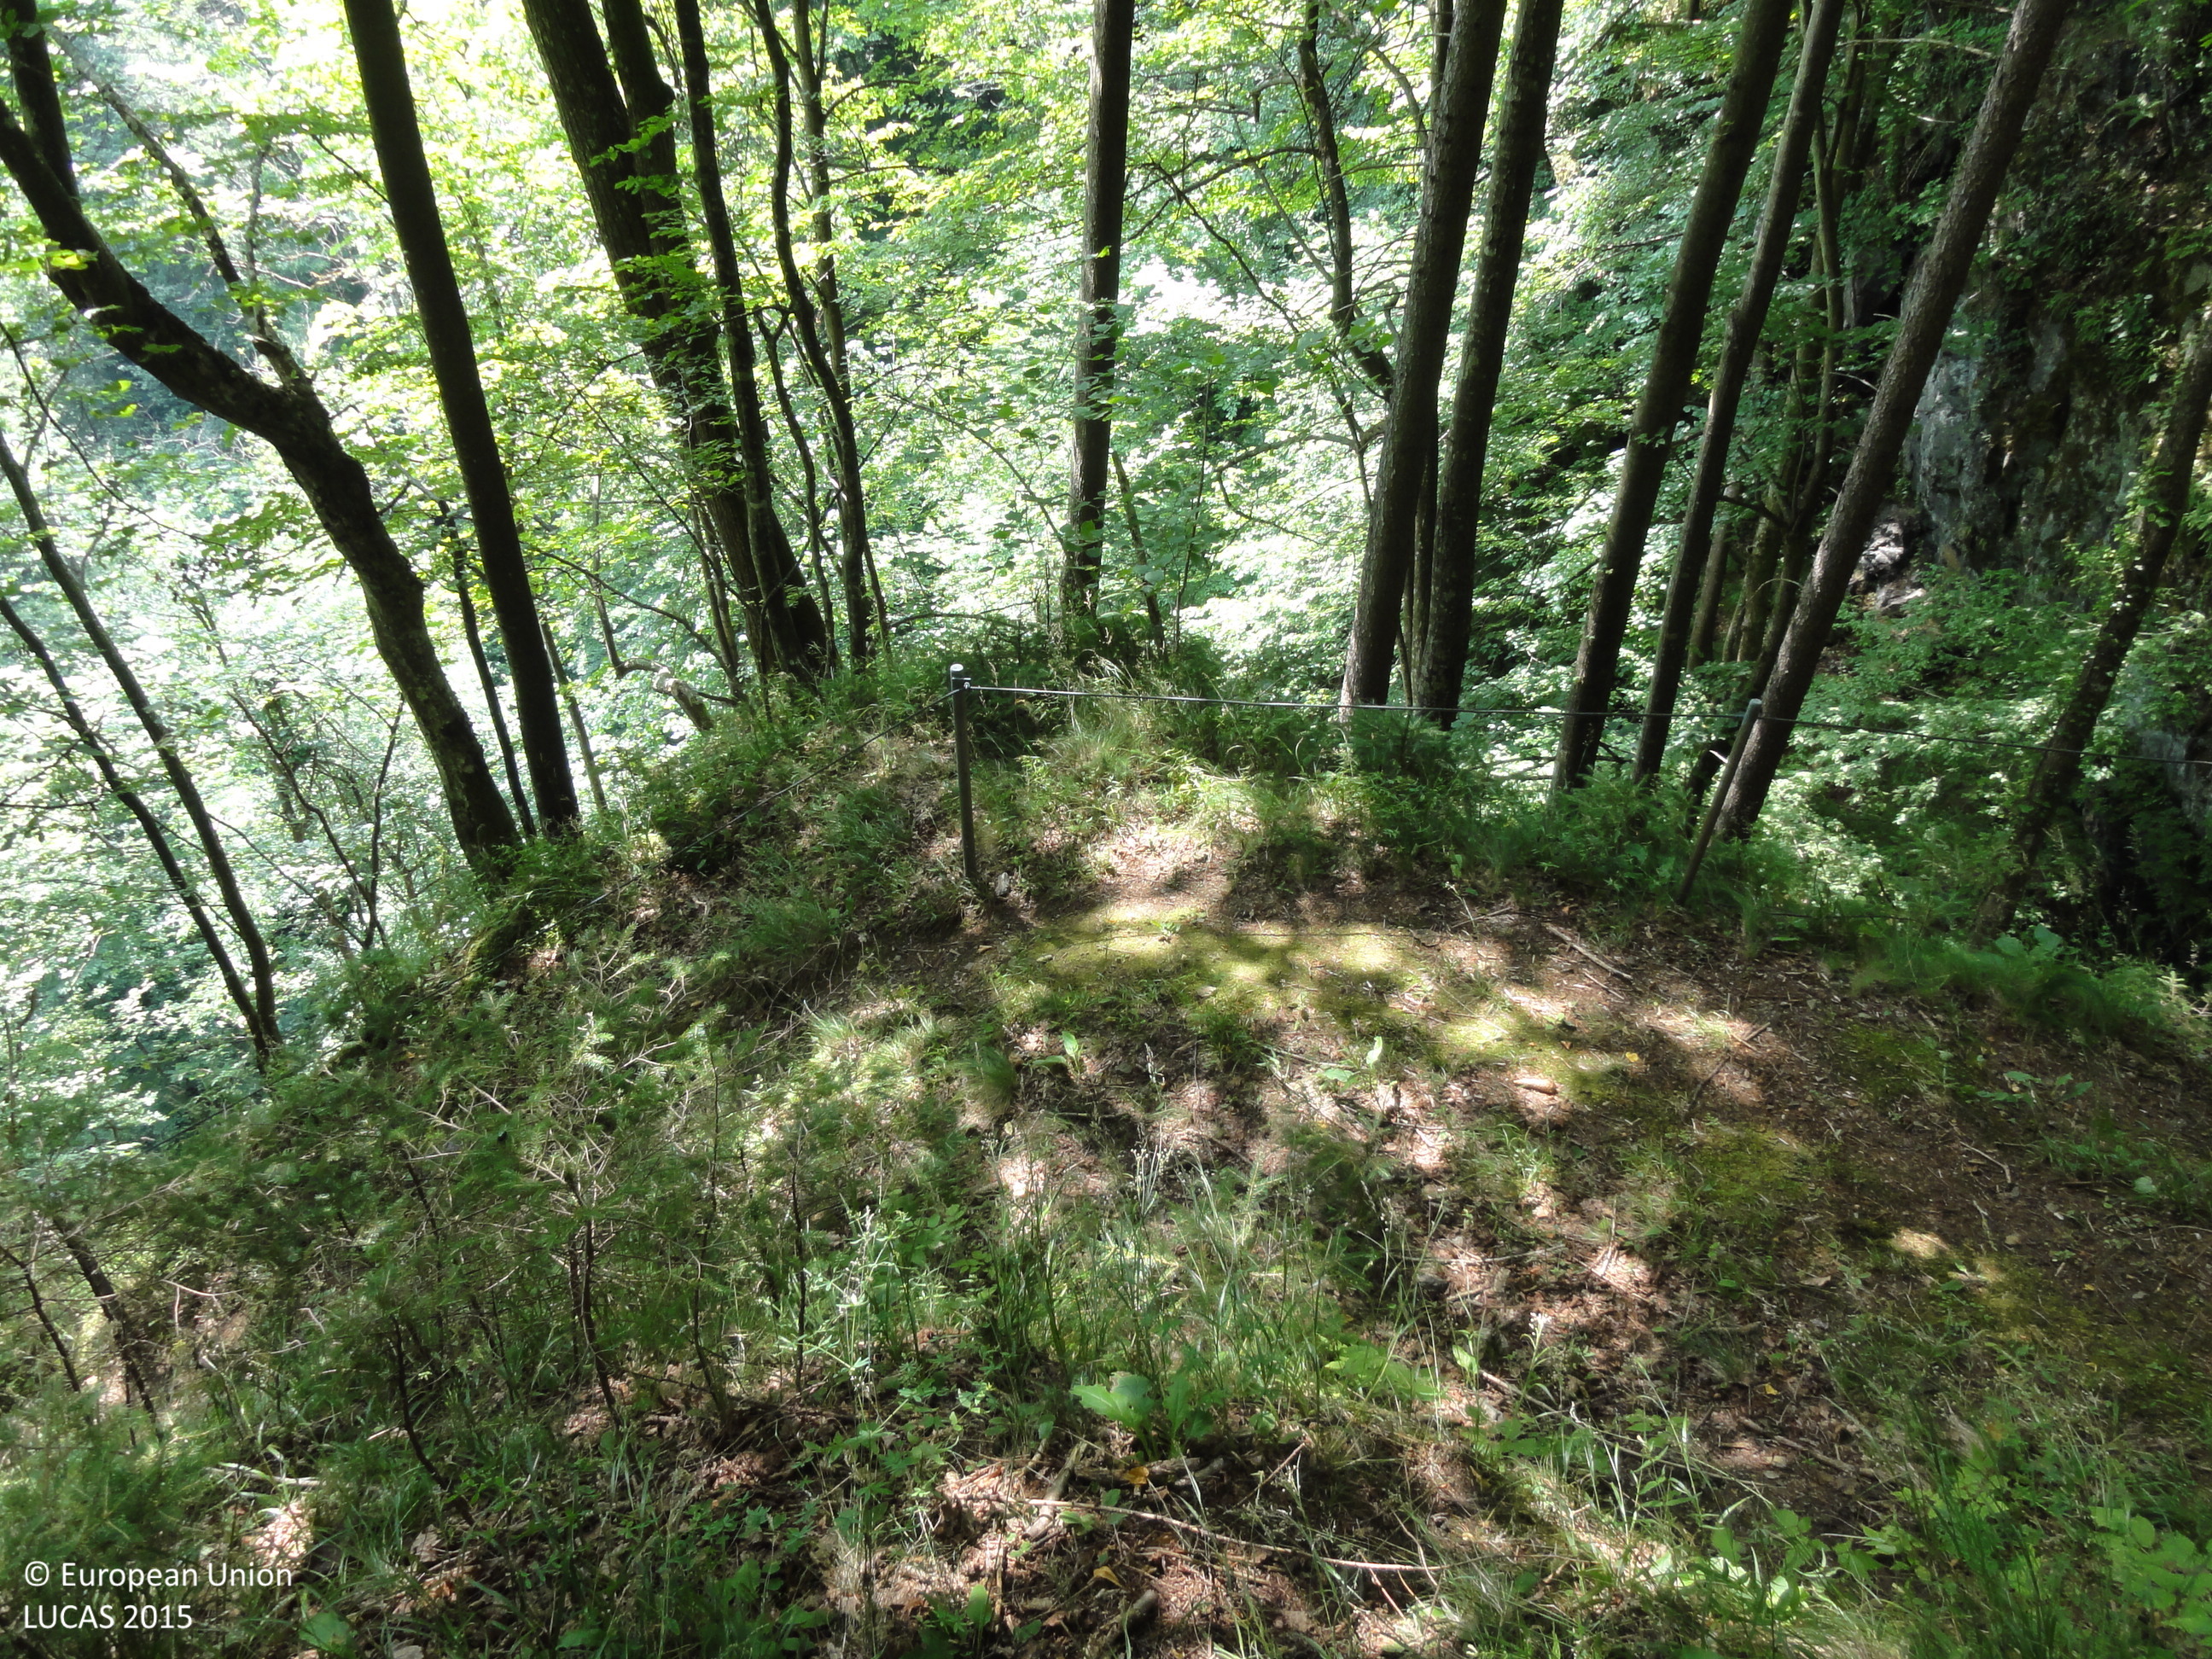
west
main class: Woodland
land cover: Spruce dominated mixed woodland
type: beech forest
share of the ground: > 75 %
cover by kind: broadleaved forest trees 75 %, coniferous forest trees 25 %
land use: Forestry
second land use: Amenities, museums, leisure
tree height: > 5 m
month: July
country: SI
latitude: 46.6431
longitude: 15.1327
